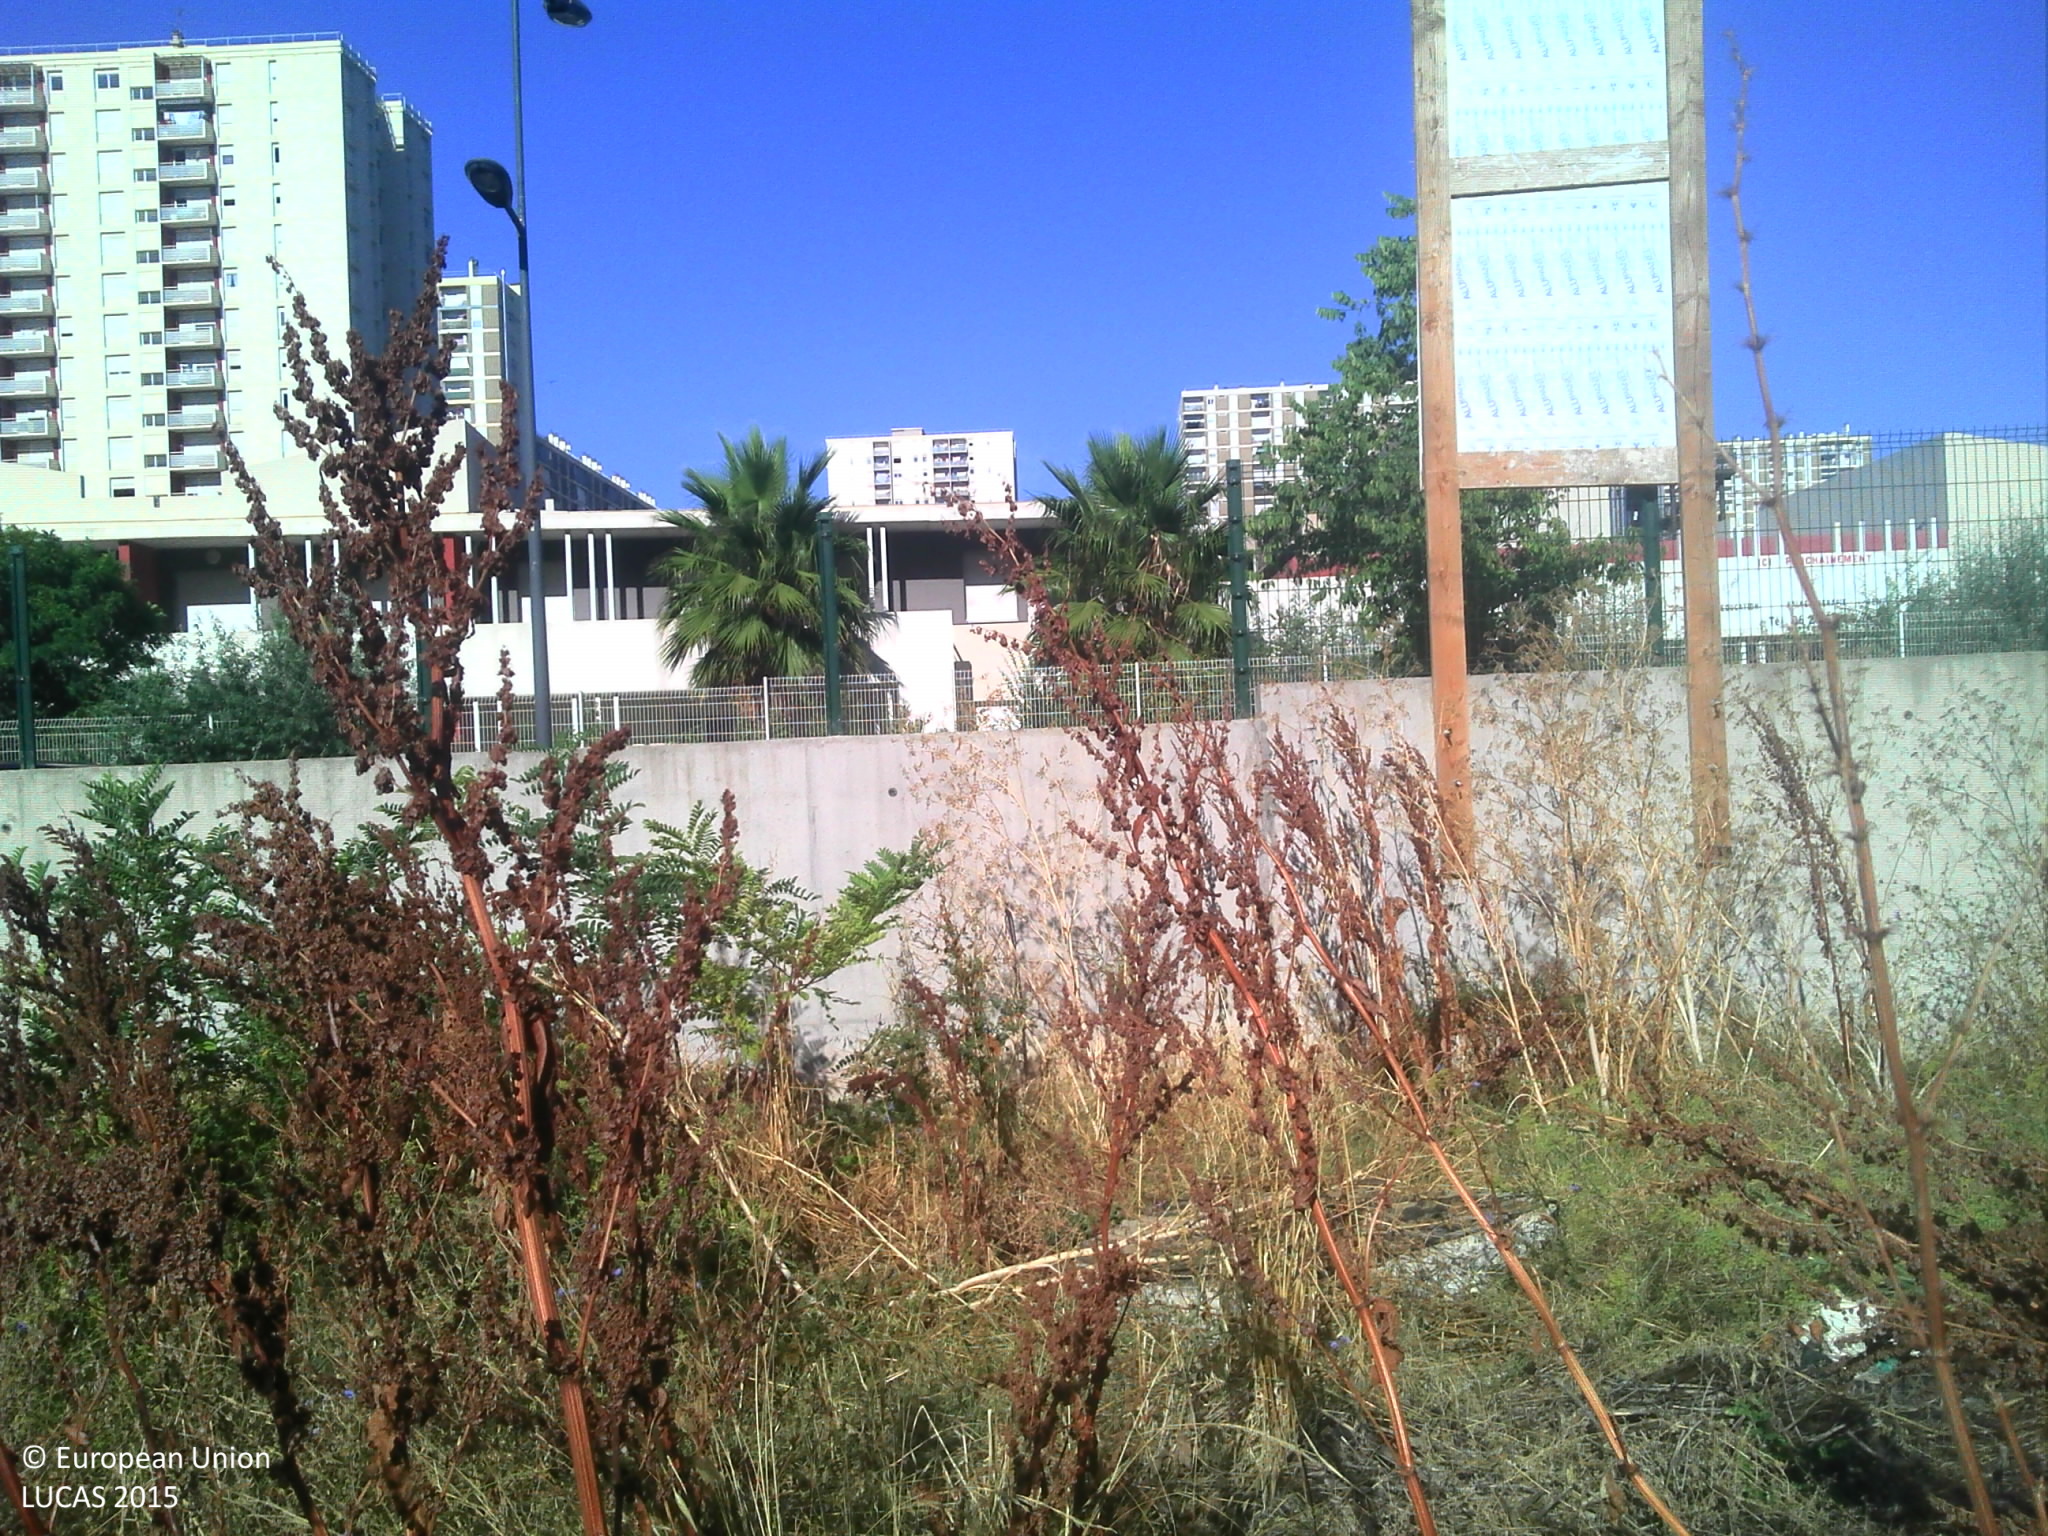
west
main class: Grassland
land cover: Grassland with sparse tree/shrub cover
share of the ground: 50 - 75 %
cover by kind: consolidated bare surface 40 %, unconsolidated bare surface 30 %, herbaceous plants 20 %, broadleaved forest trees 5 %, shrubs 5 %
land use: Abandoned areas
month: August
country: FR
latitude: 43.3275
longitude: 5.4103
